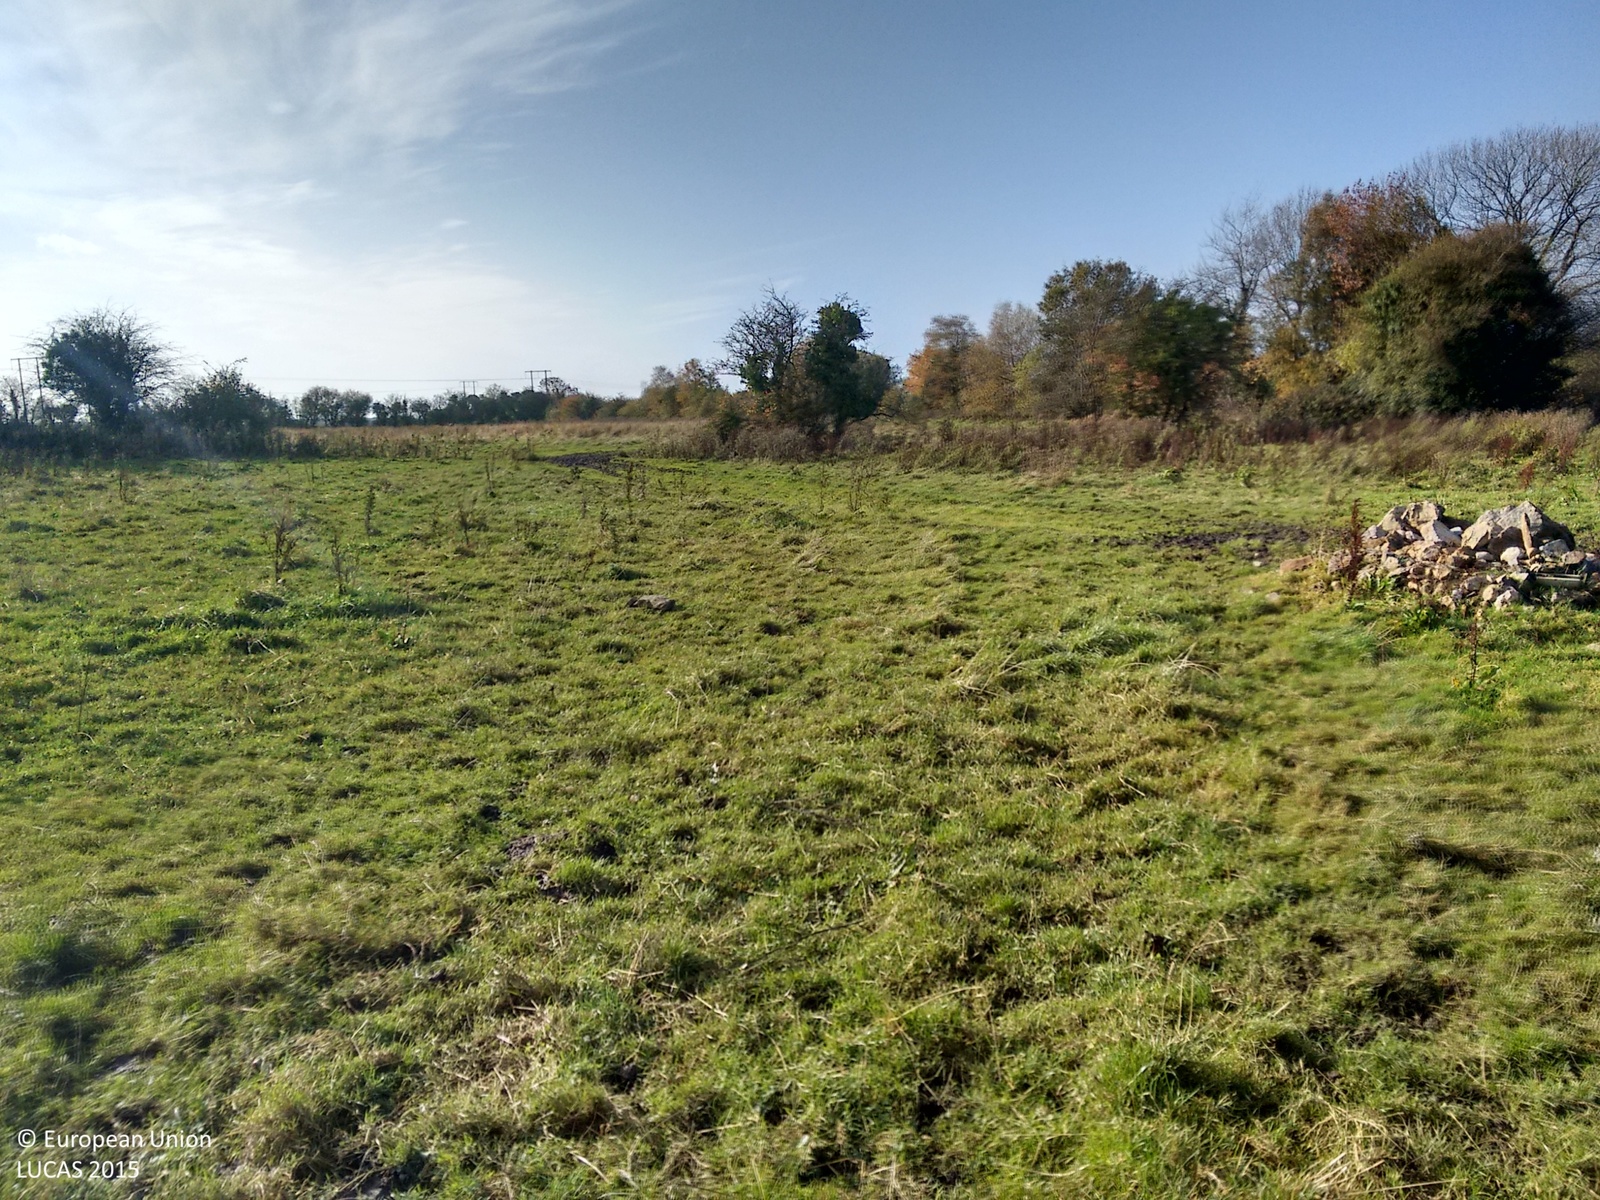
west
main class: Grassland
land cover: Grassland without tree/shrub cover
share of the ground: > 75 %
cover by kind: herbaceous plants 95 %, shrubs 5 %
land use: Agriculture (excluding fallow land and kitchen gardens)
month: October
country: IE
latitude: 53.2247
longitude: -7.8292
